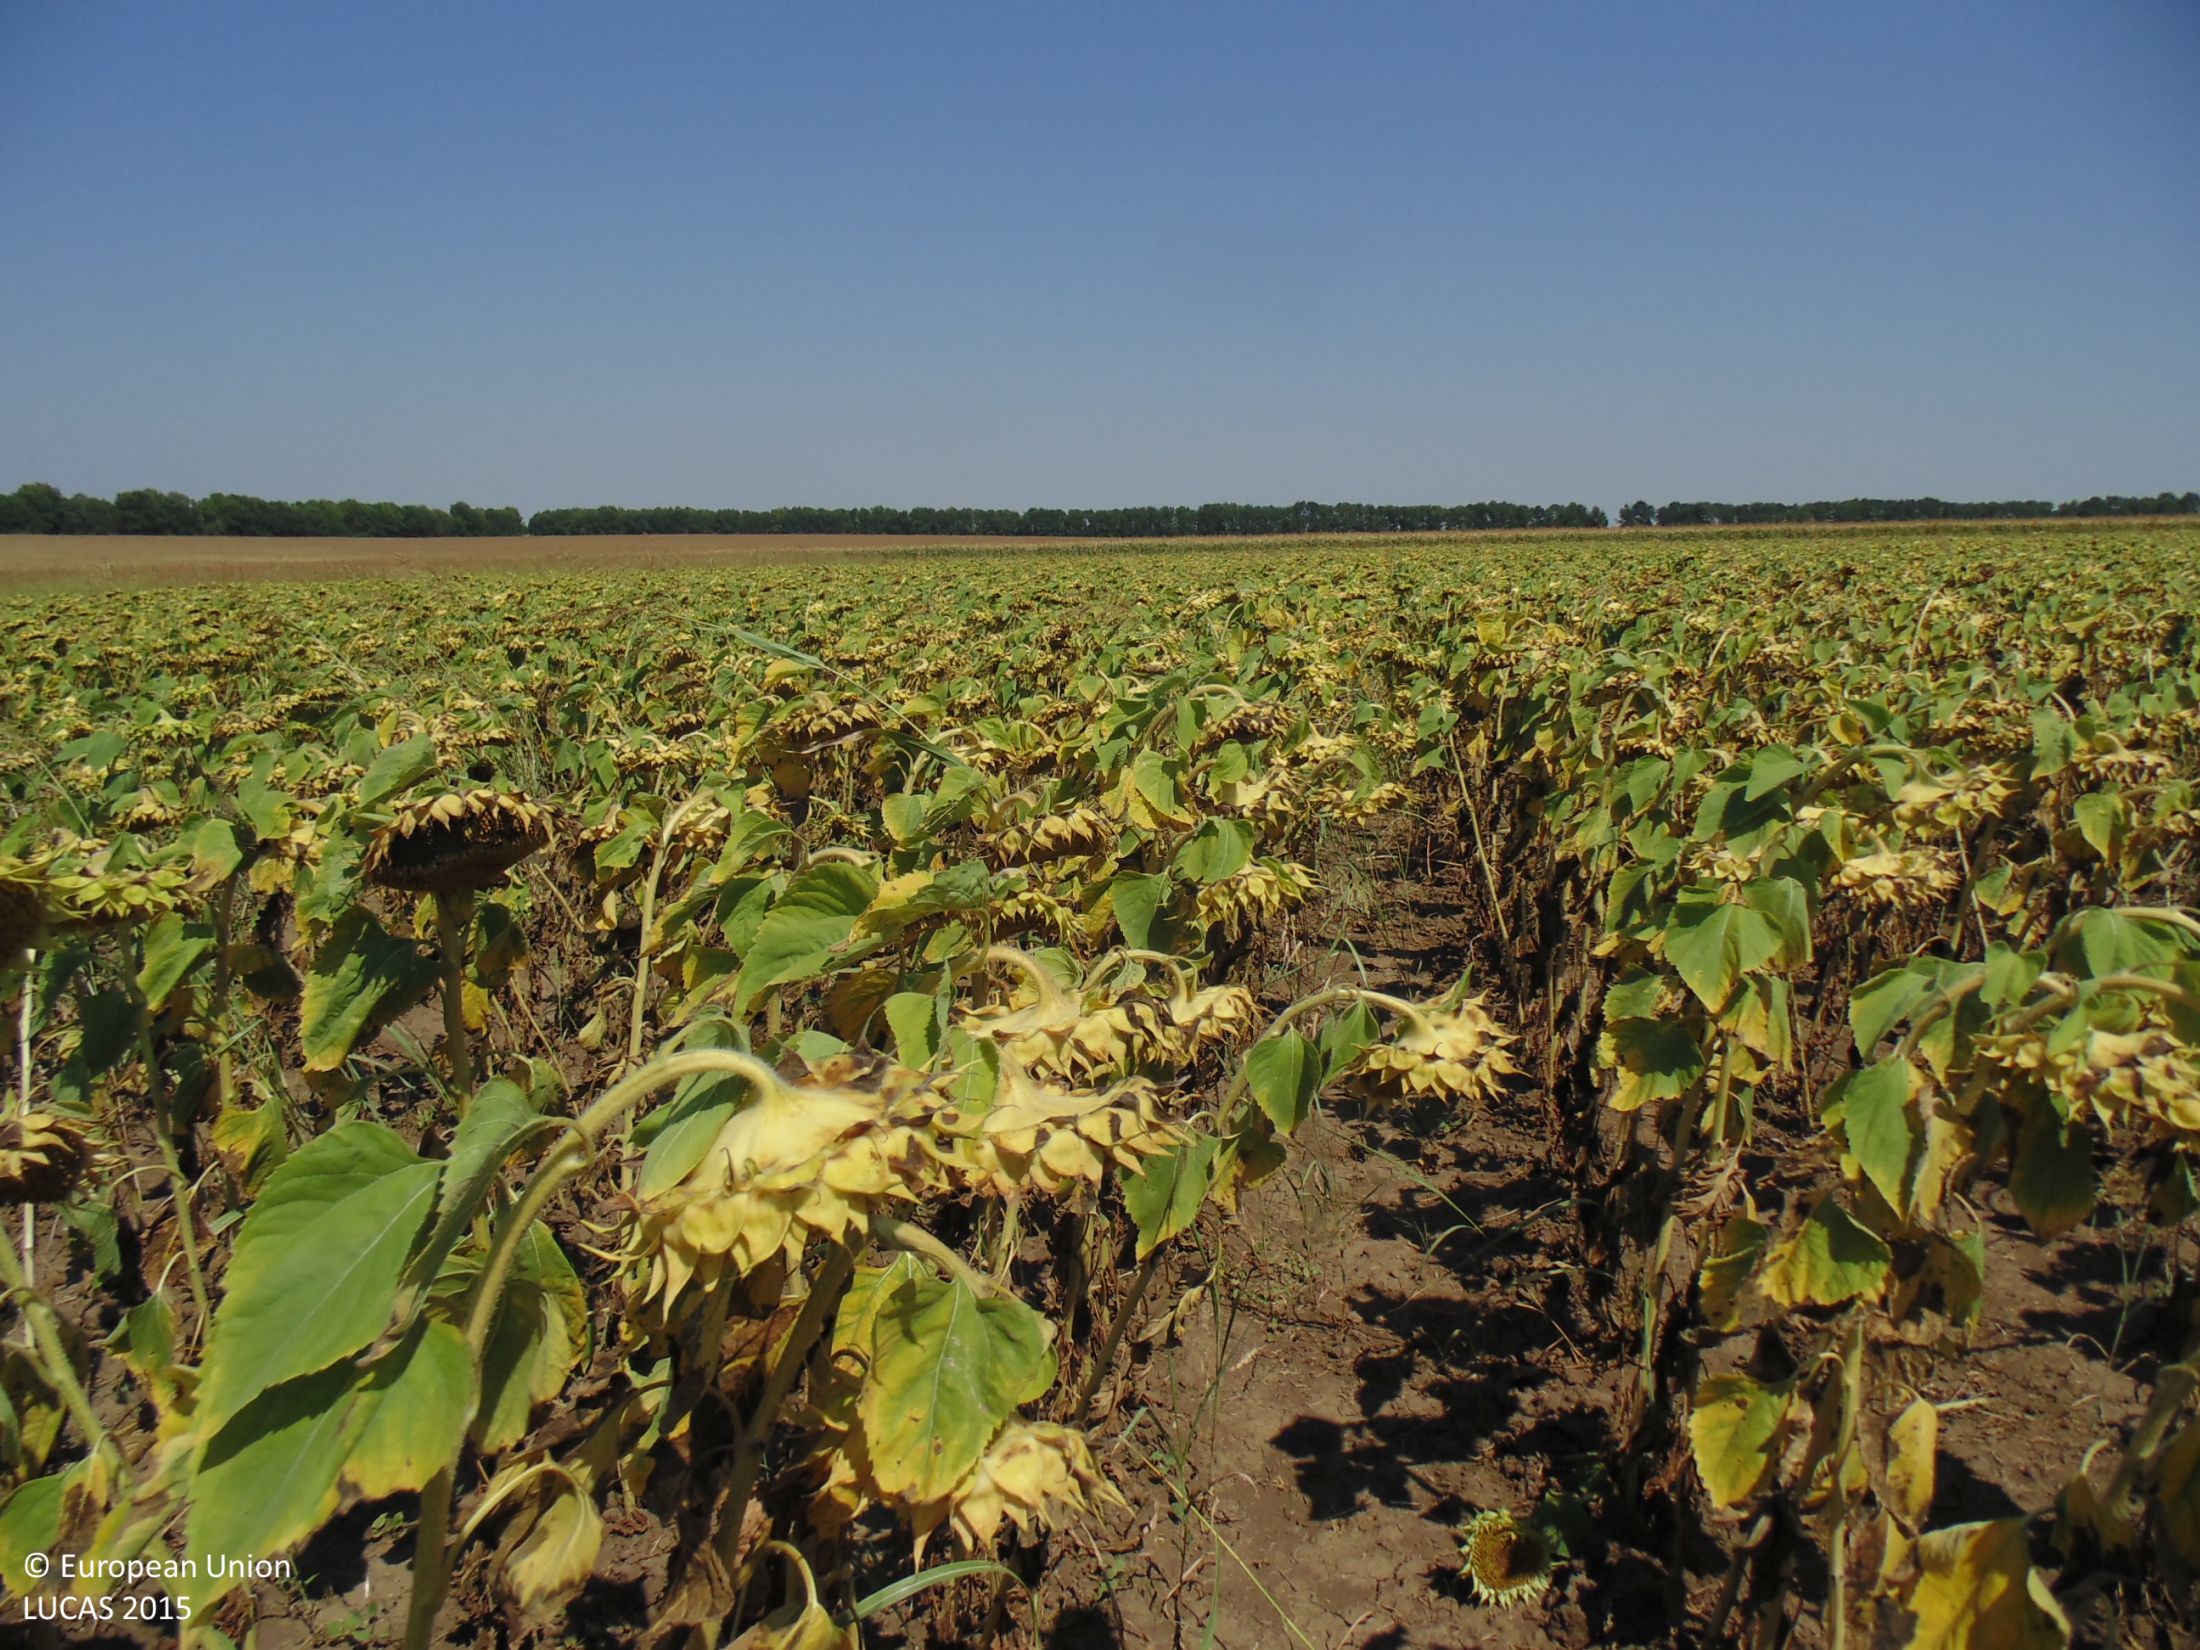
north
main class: Cropland
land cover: Sunflower
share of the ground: > 75 %
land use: Agriculture (excluding fallow land and kitchen gardens)
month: August
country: BG
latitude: 43.7313
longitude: 28.2446
